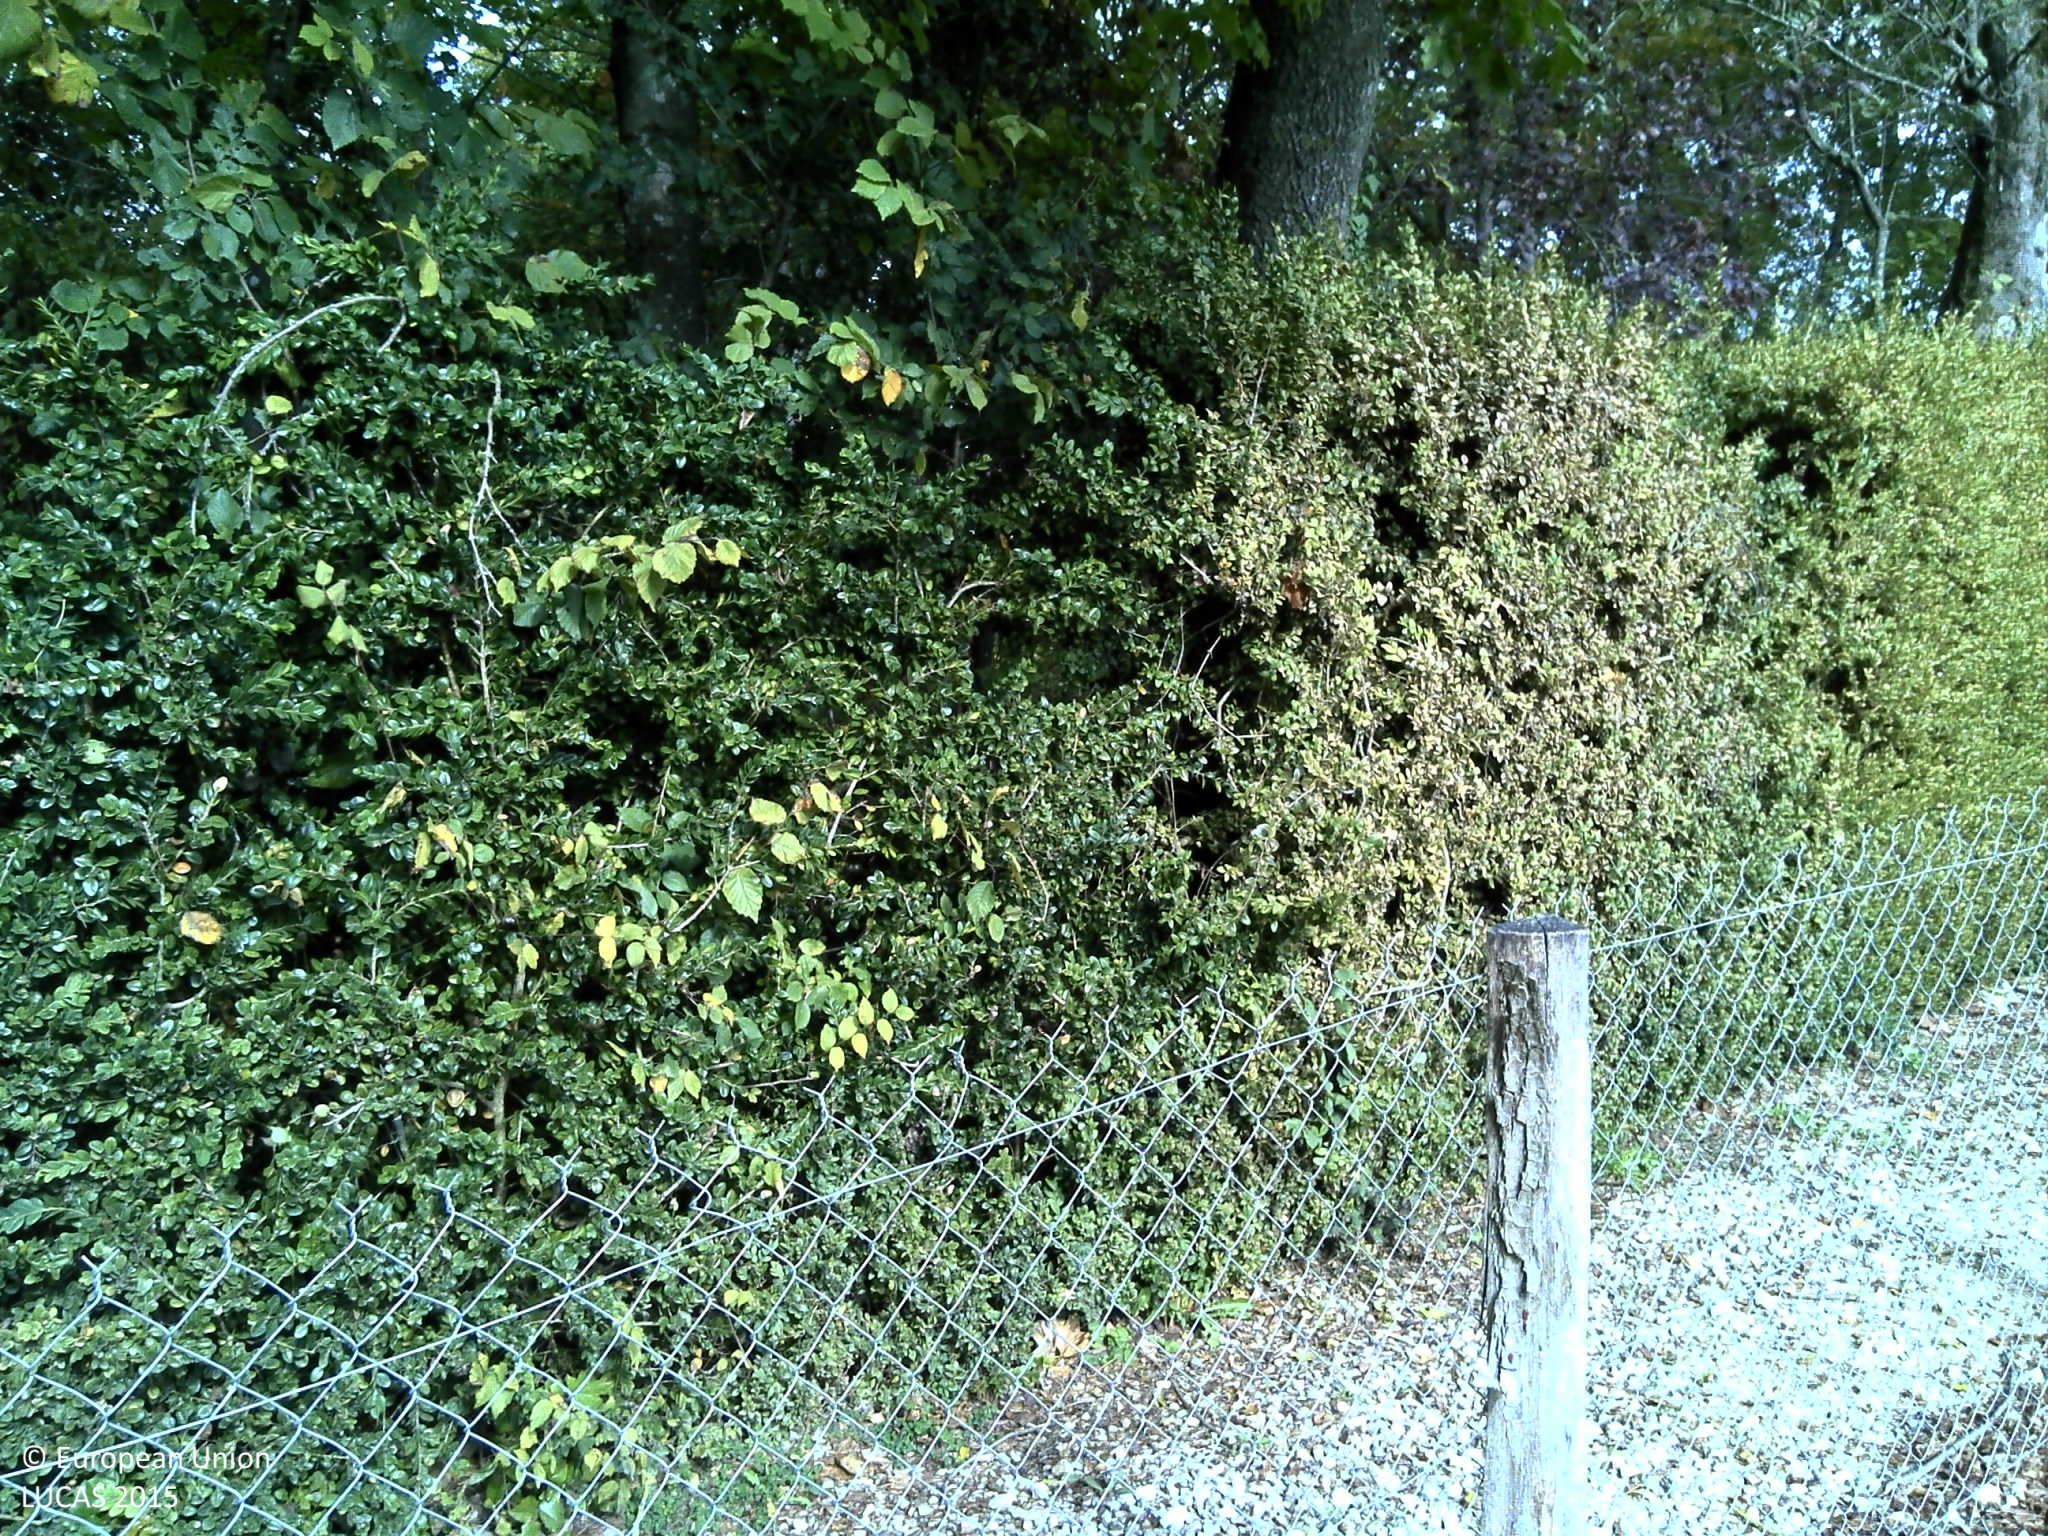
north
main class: Woodland
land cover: Broadleaved woodland
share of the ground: > 75 %
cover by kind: broadleaved forest trees 80 %, coniferous forest trees 10 %, shrubs 5 %, unconsolidated bare surface 5 %
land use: Residential
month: July
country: FR
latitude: 46.9304
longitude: 4.8392
